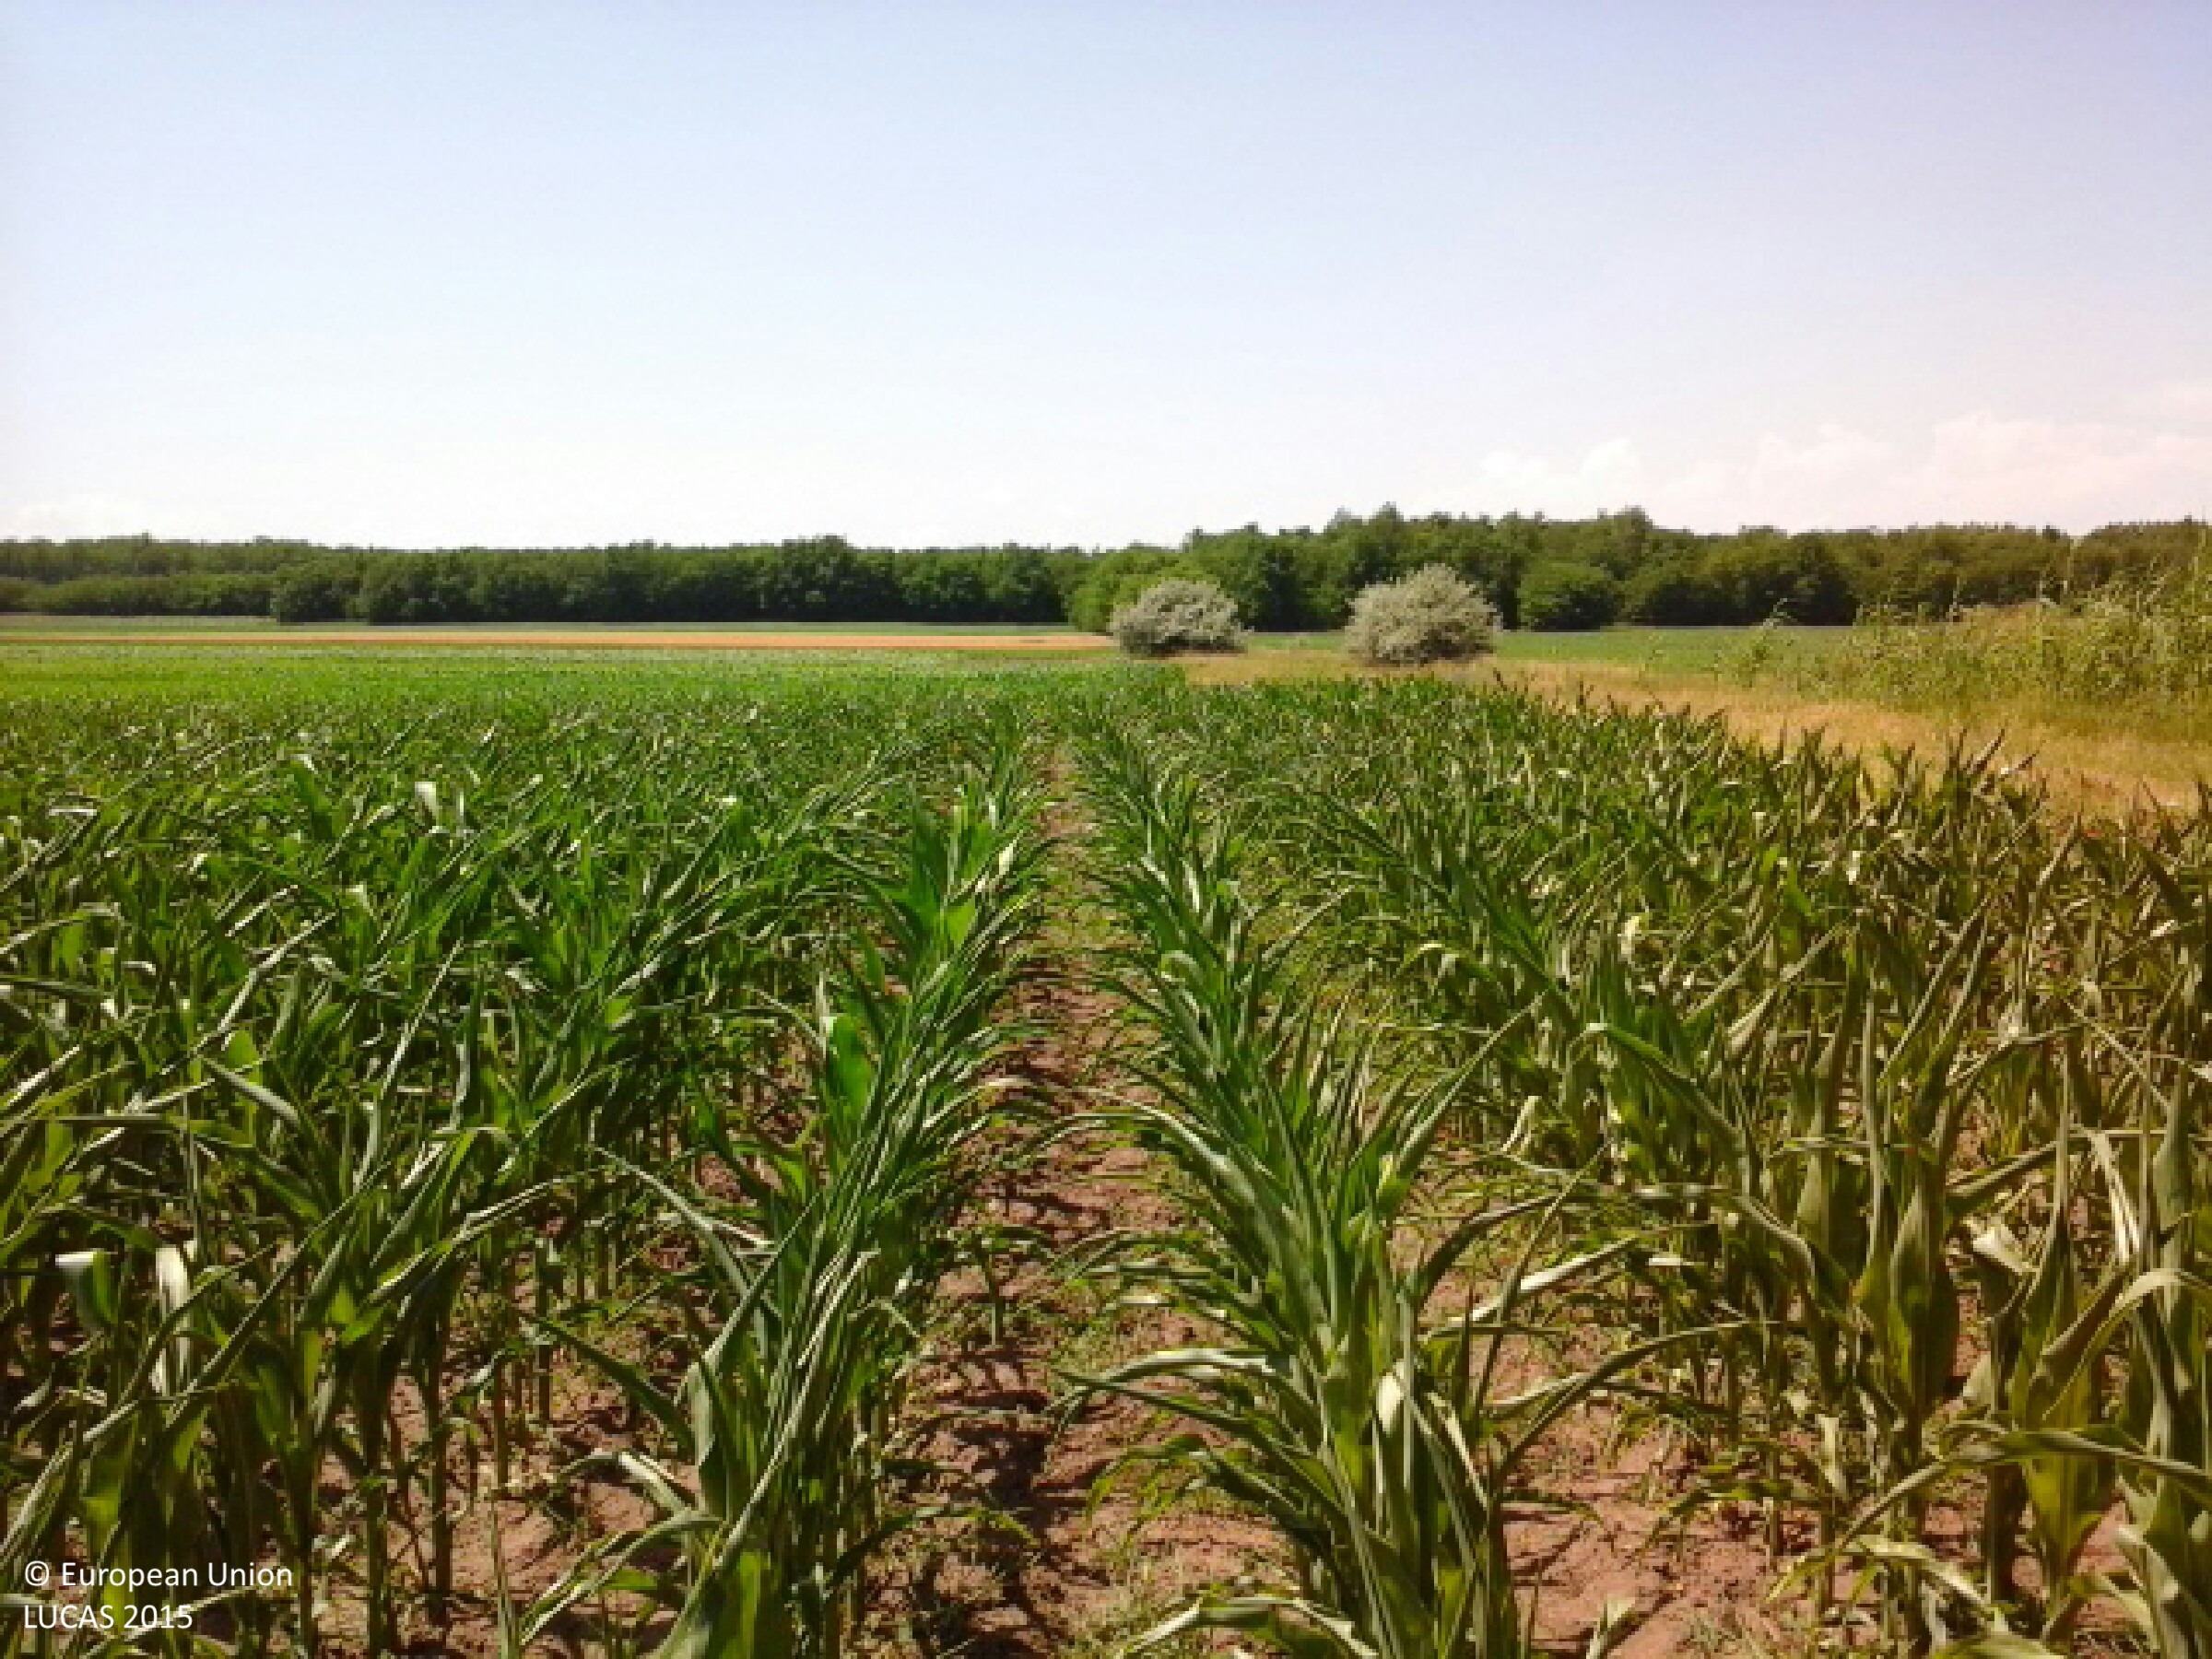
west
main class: Cropland
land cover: Maize
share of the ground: 50 - 75 %
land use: Agriculture (excluding fallow land and kitchen gardens)
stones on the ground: < 10 %
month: June
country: HU
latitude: 47.8539
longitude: 21.6879
